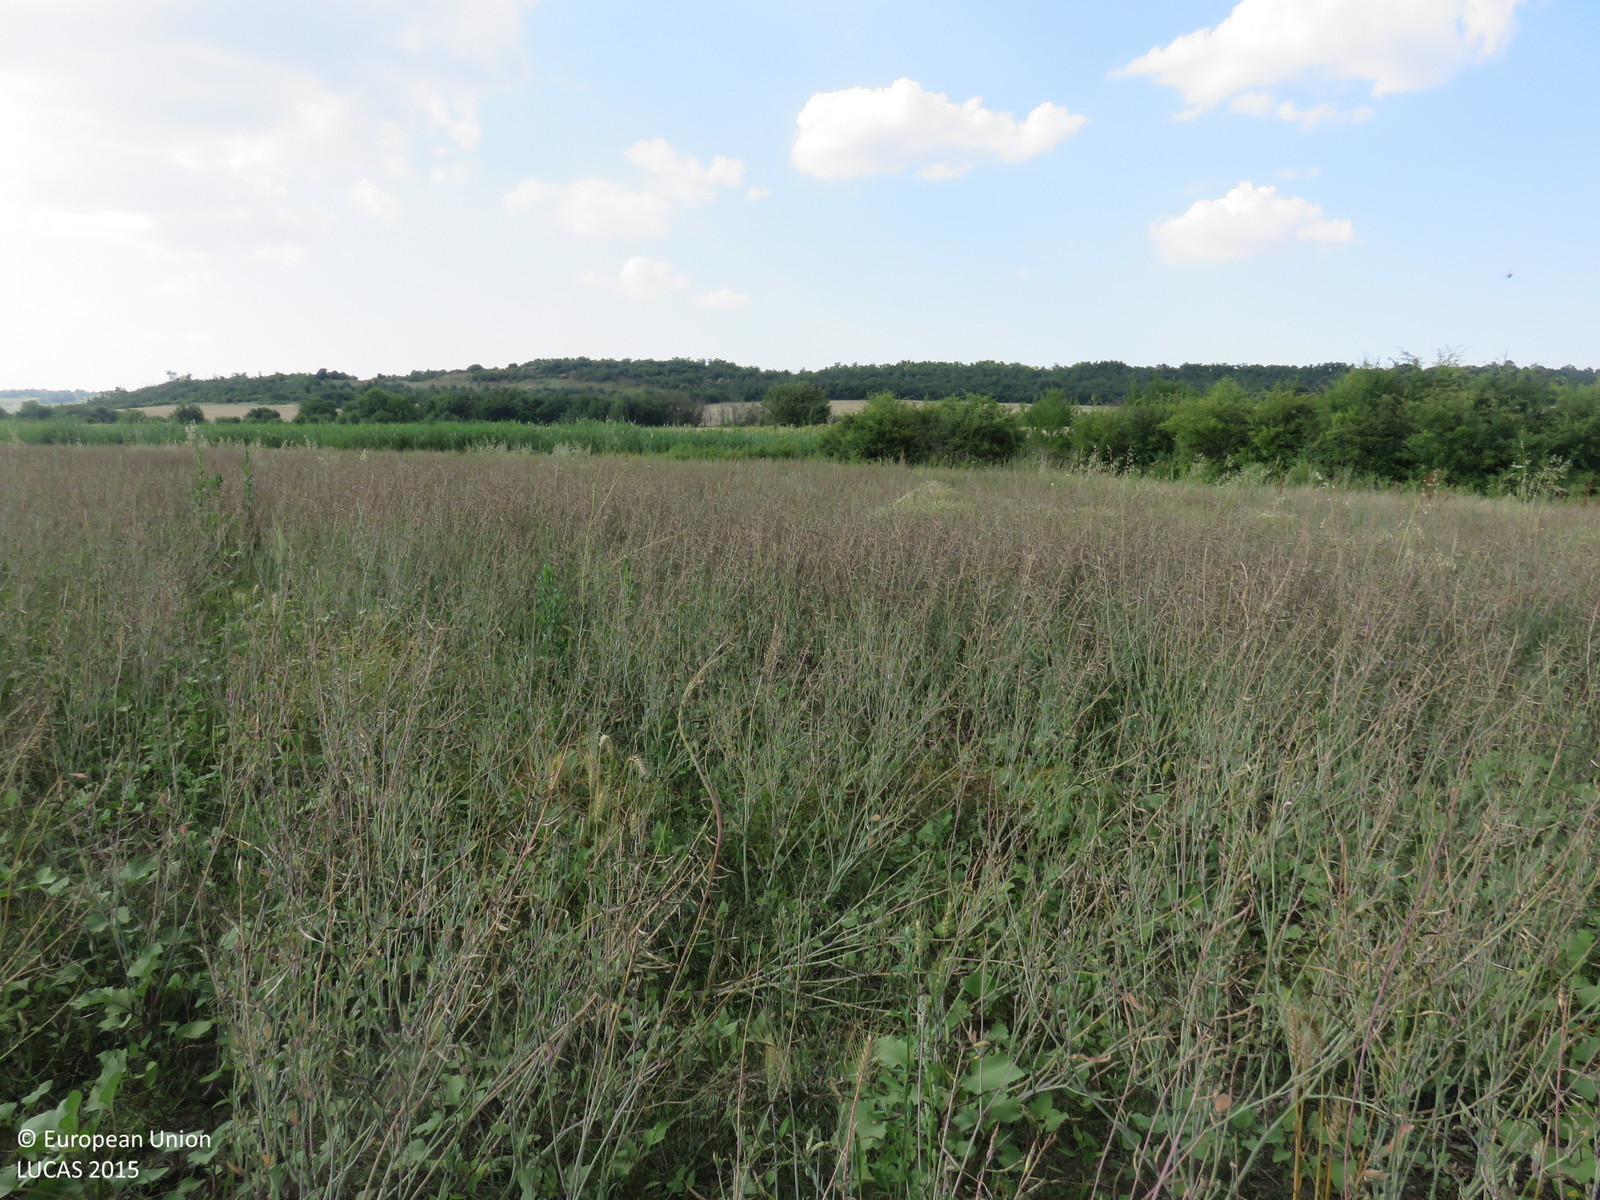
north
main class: Cropland
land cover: Rape and turnip rape
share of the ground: > 75 %
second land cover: Spontaneously vegetated surfaces
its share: 50 - 75 %
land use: Agriculture (excluding fallow land and kitchen gardens)
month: June
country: BG
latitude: 43.2941
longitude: 24.8445
